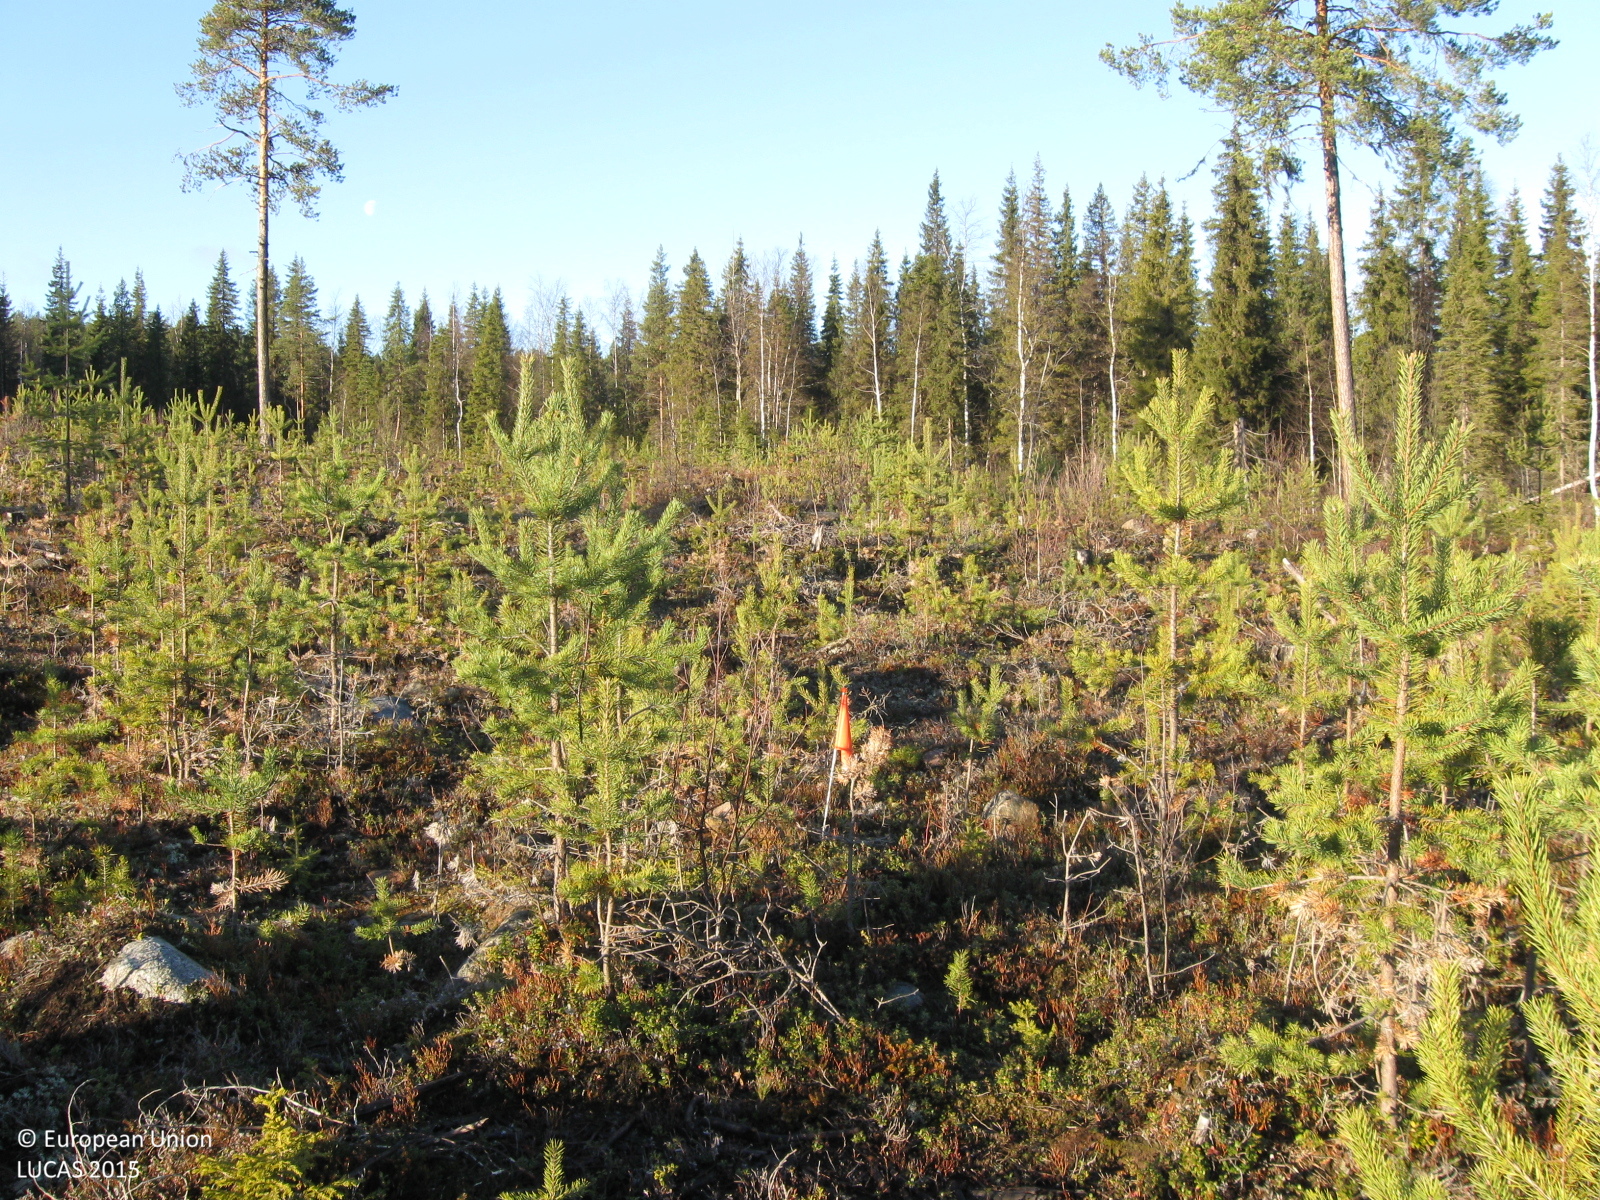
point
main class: Woodland
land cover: Pine dominated coniferous woodland
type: boreal forest
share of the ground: 25 - 50 %
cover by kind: coniferous forest trees 30 %, shrubs 20 %, herbaceous plants 10 %, lichens and mosses 10 %, consolidated bare surface 10 %, unconsolidated bare surface 10 %, broadleaved forest trees 5 %
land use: Forestry
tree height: < 5 m
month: November
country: SE
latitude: 66.1134
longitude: 20.7845
